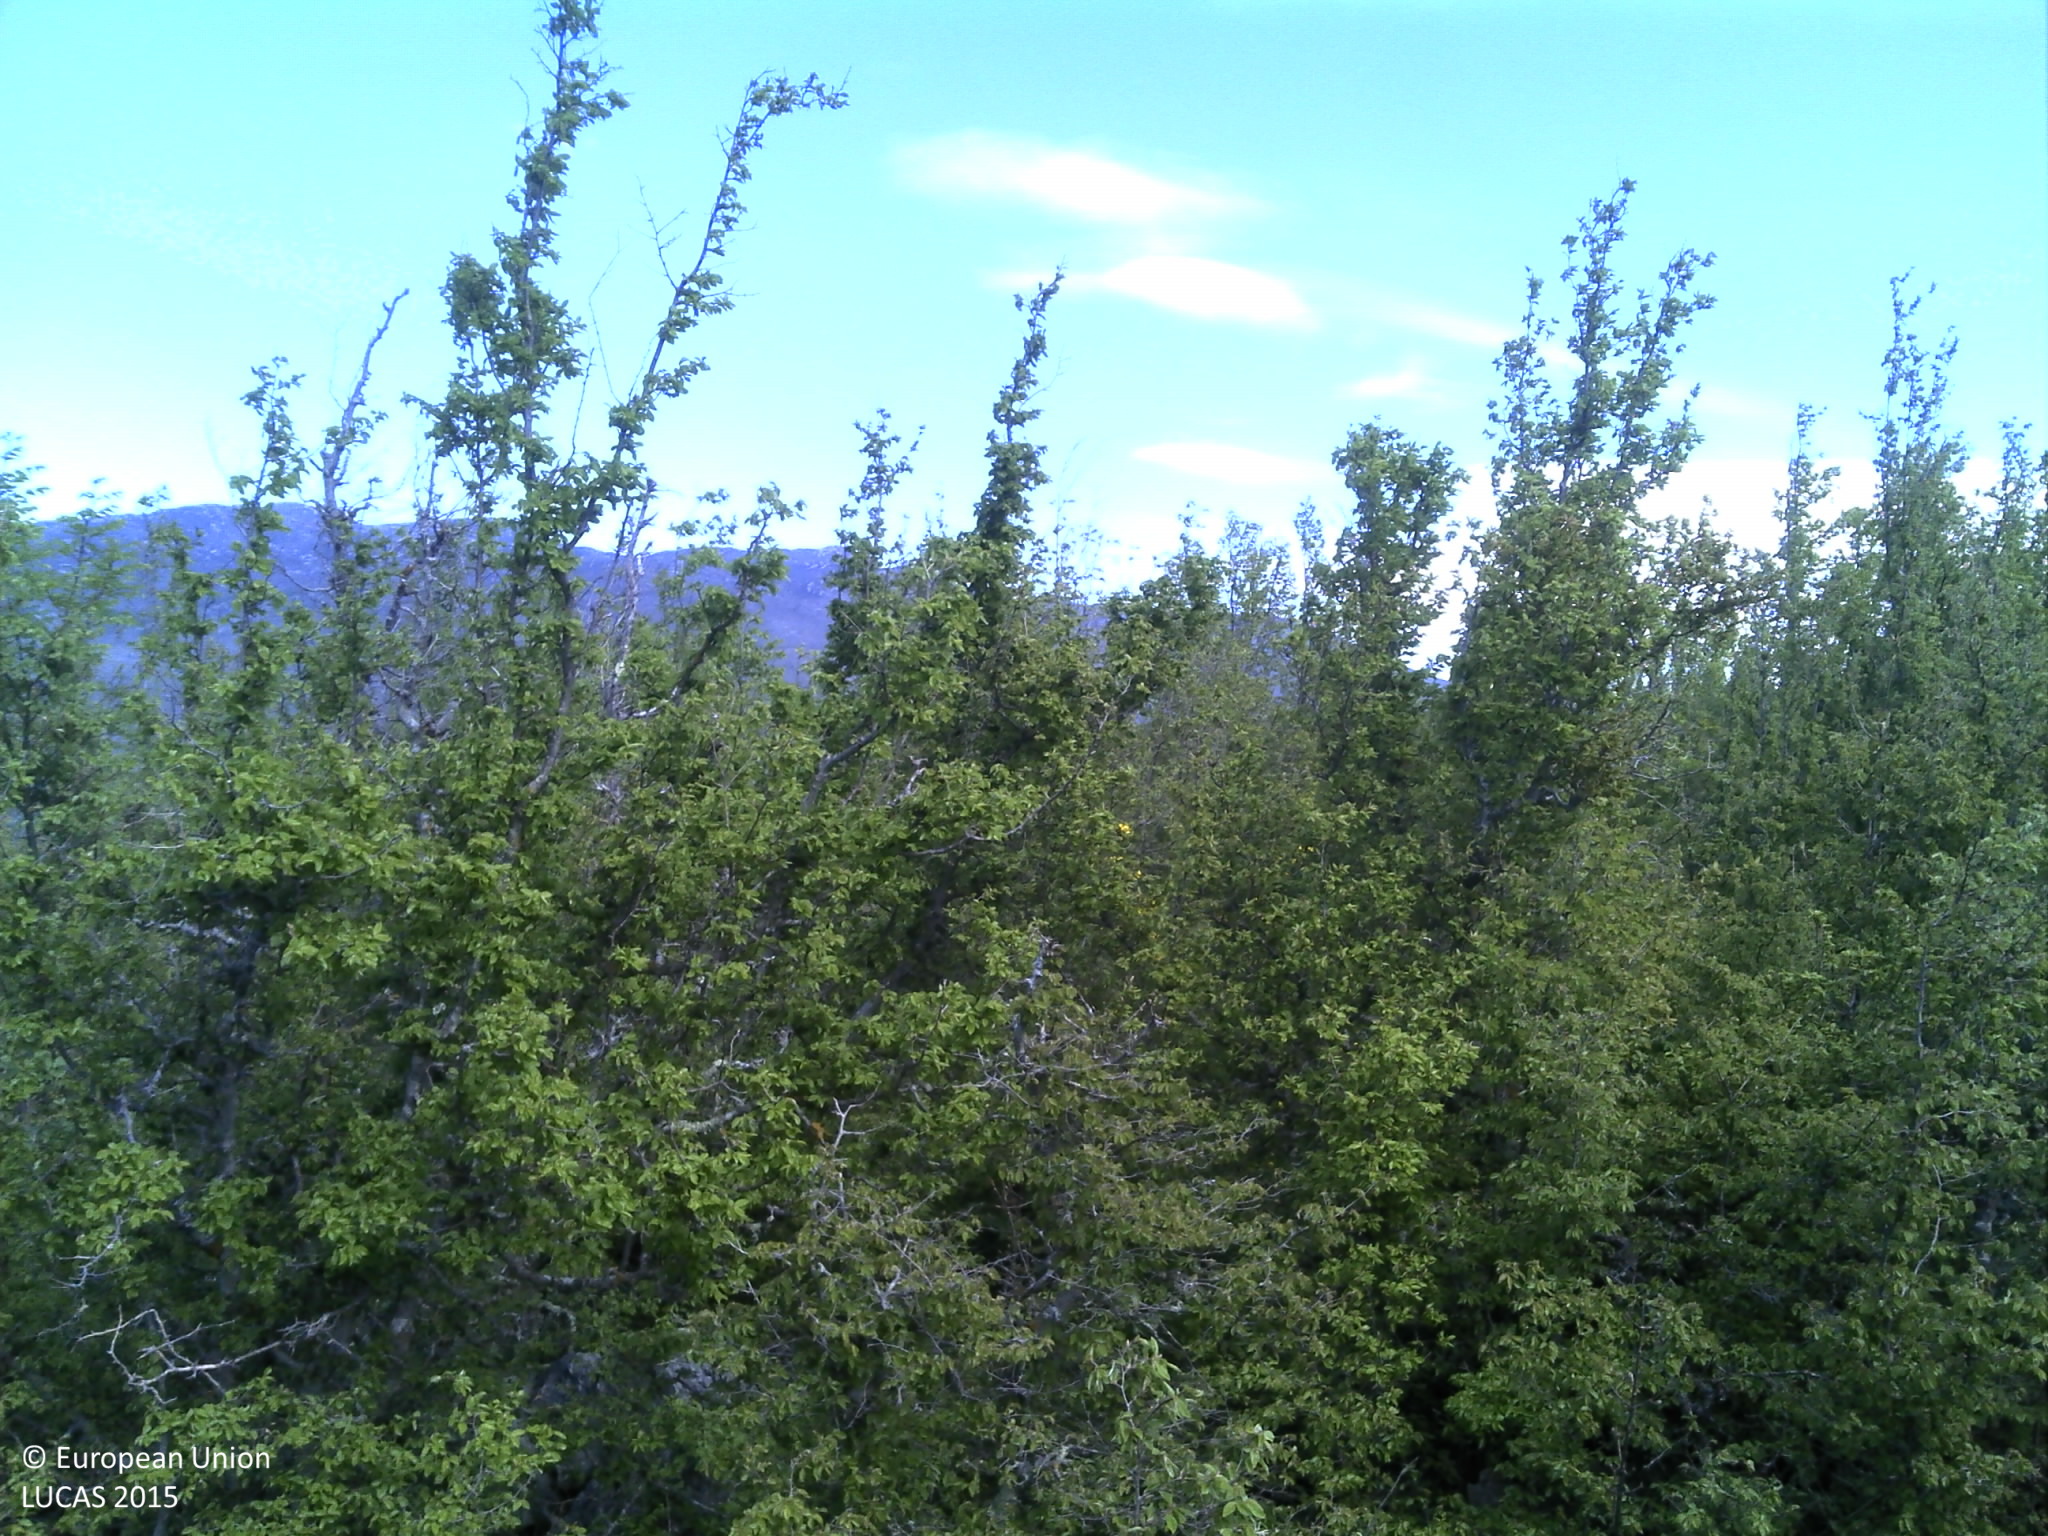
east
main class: Woodland
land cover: Broadleaved woodland
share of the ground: > 75 %
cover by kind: broadleaved forest trees 90 %, herbaceous plants 5 %, unconsolidated bare surface 5 %
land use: Semi-natural and natural areas not in use
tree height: < 5 m
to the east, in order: Broadleaved woodland; Tracks; Broadleaved woodland
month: April
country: HR
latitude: 44.1835
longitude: 15.8846
